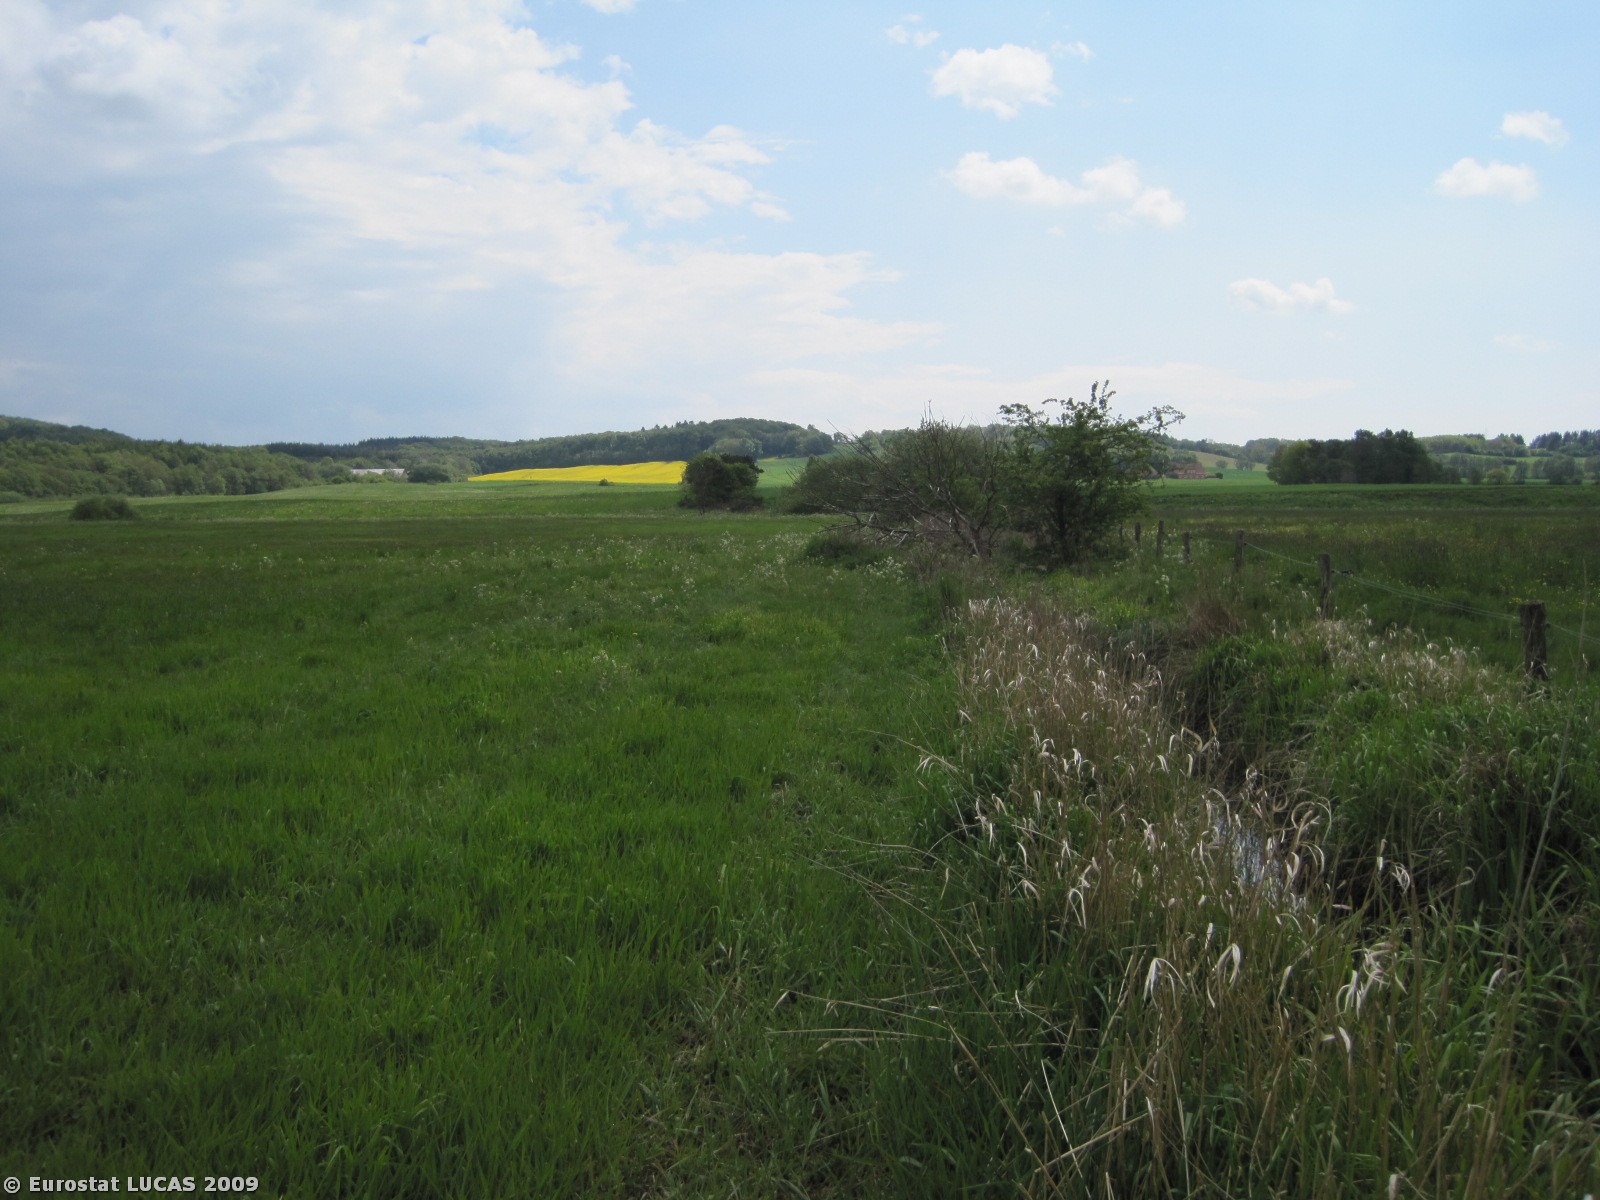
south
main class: Wetlands
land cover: Inland marshes
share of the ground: > 75 %
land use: Unused
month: May
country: DK
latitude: 56.3852
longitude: 9.7250
